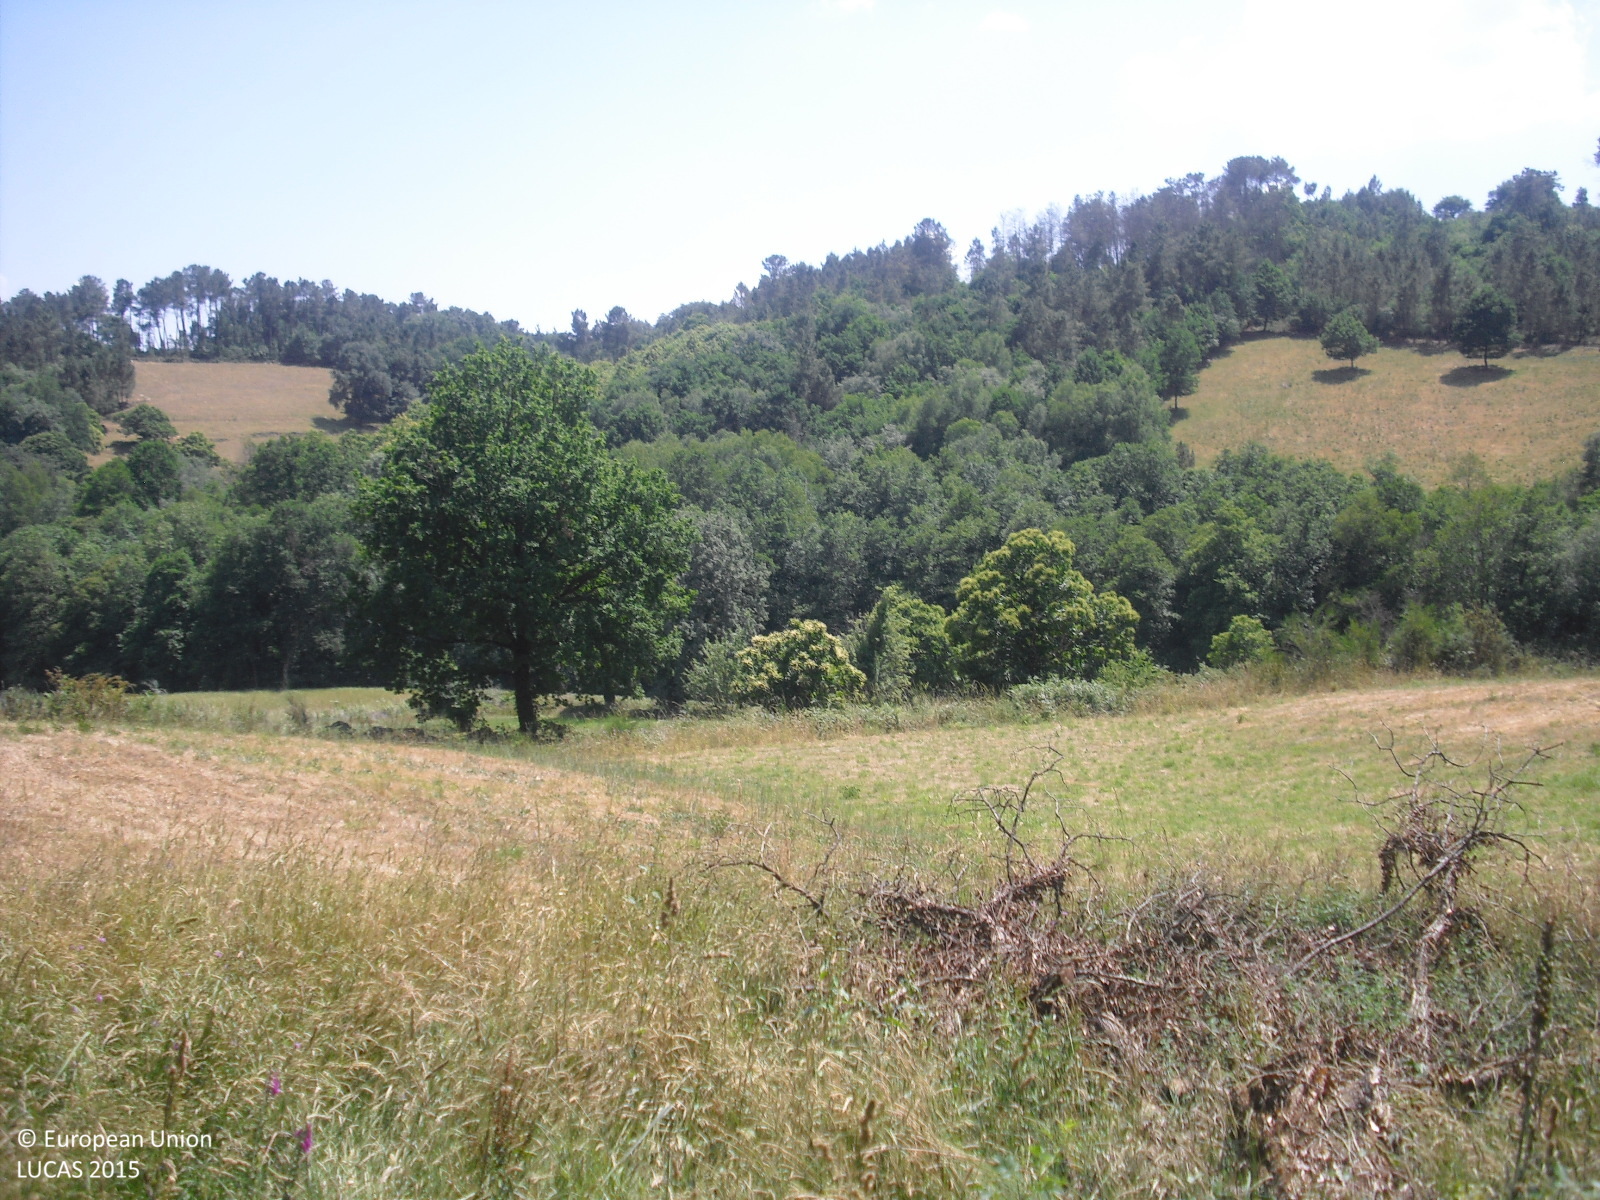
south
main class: Grassland
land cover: Grassland without tree/shrub cover
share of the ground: > 75 %
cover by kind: herbaceous plants 100 %
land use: Agriculture (excluding fallow land and kitchen gardens)
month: June
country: ES
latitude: 42.6658
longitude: -7.8077
